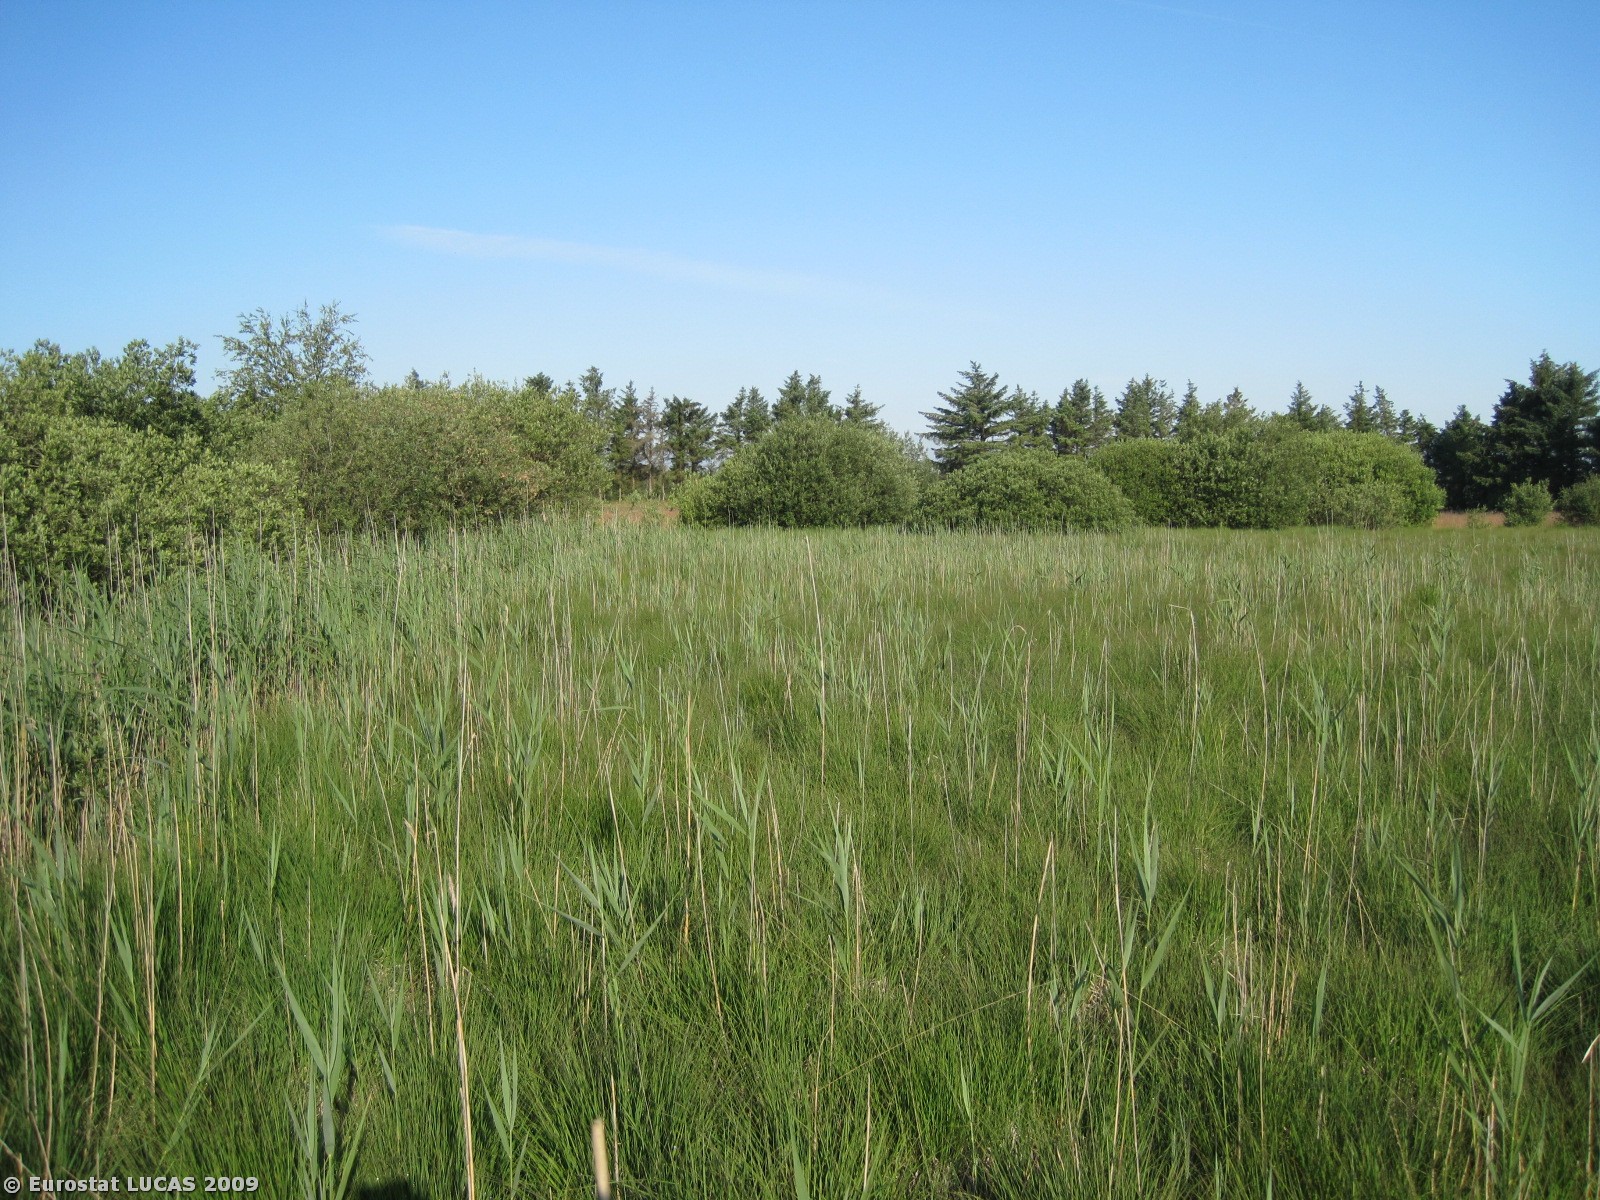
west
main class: Wetlands
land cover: Inland marshes
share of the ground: > 75 %
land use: Unused
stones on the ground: < 10 %
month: July
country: DK
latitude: 56.3739
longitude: 8.2695
